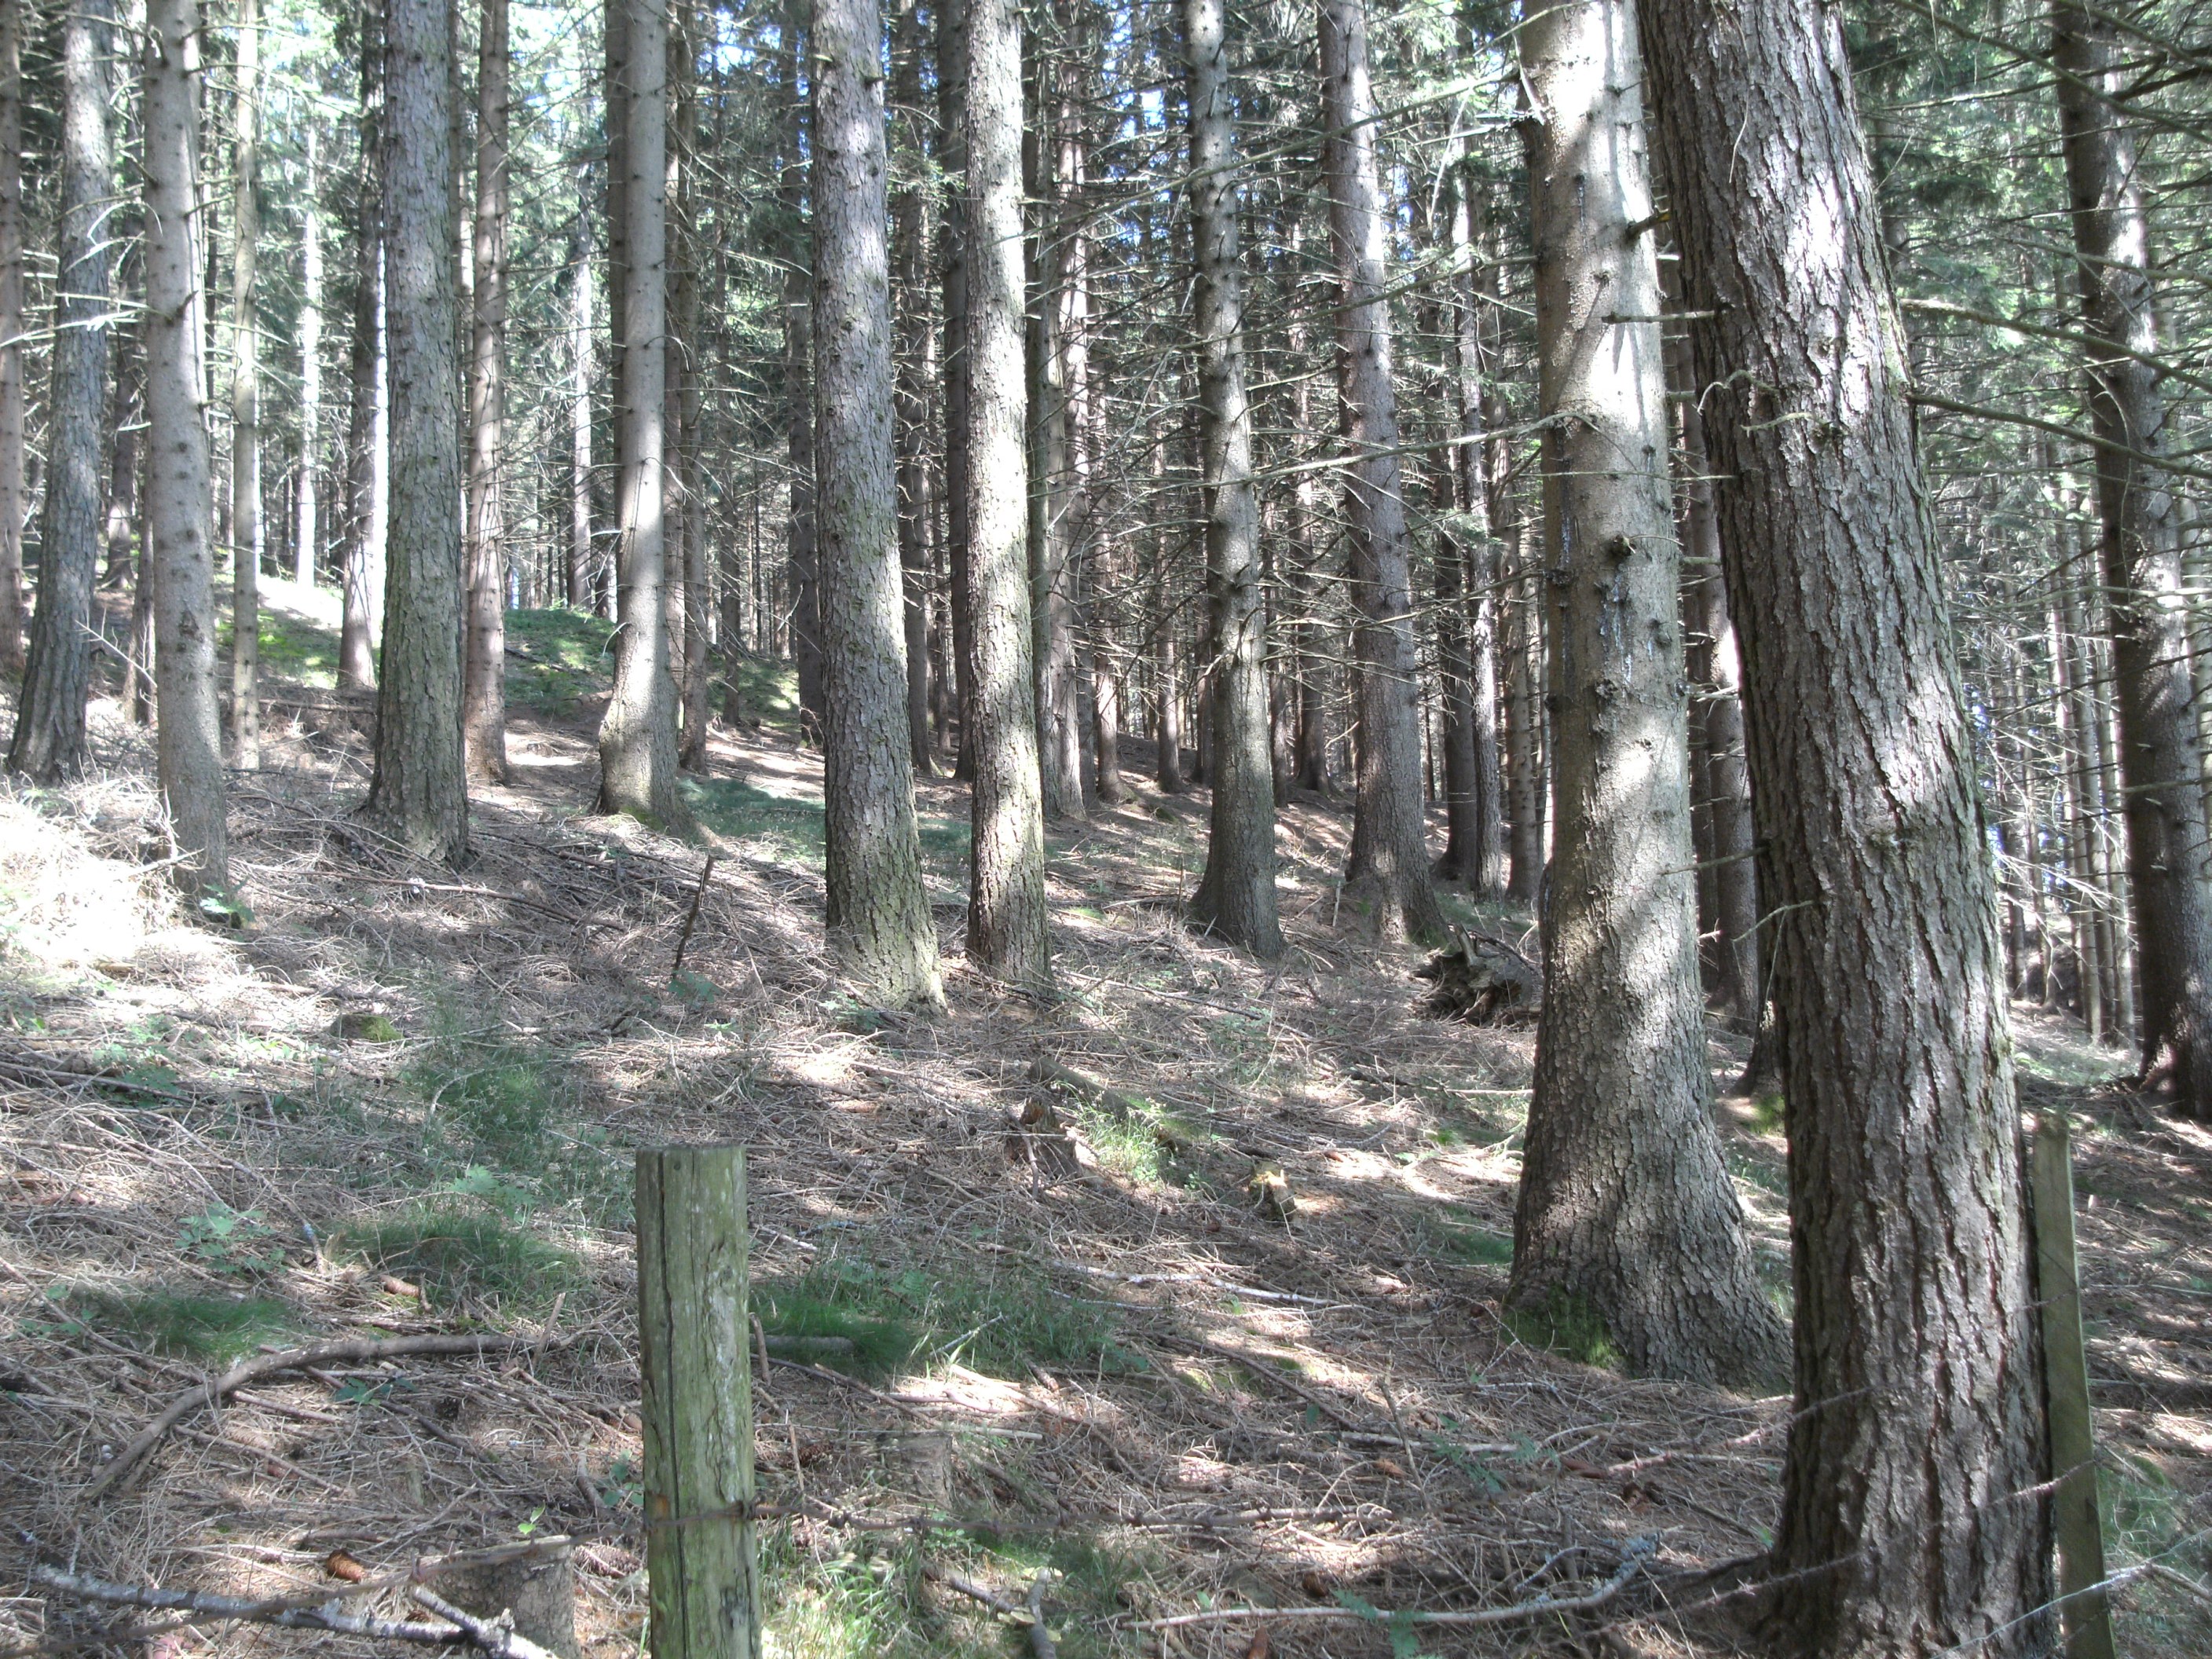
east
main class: Woodland
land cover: Spruce dominated coniferous woodland
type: alpine coniferous forest
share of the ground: > 75 %
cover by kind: coniferous forest trees 90 %, herbaceous plants 5 %, unconsolidated bare surface 5 %
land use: Forestry
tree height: > 5 m
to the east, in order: Spruce dominated coniferous woodland; Fences; Spruce dominated coniferous woodland; Fences; Grassland without tree/shrub cover; Single bushes/trees; Artificial constructions in urban areas
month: July
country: AT
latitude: 46.7891
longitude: 14.7009
